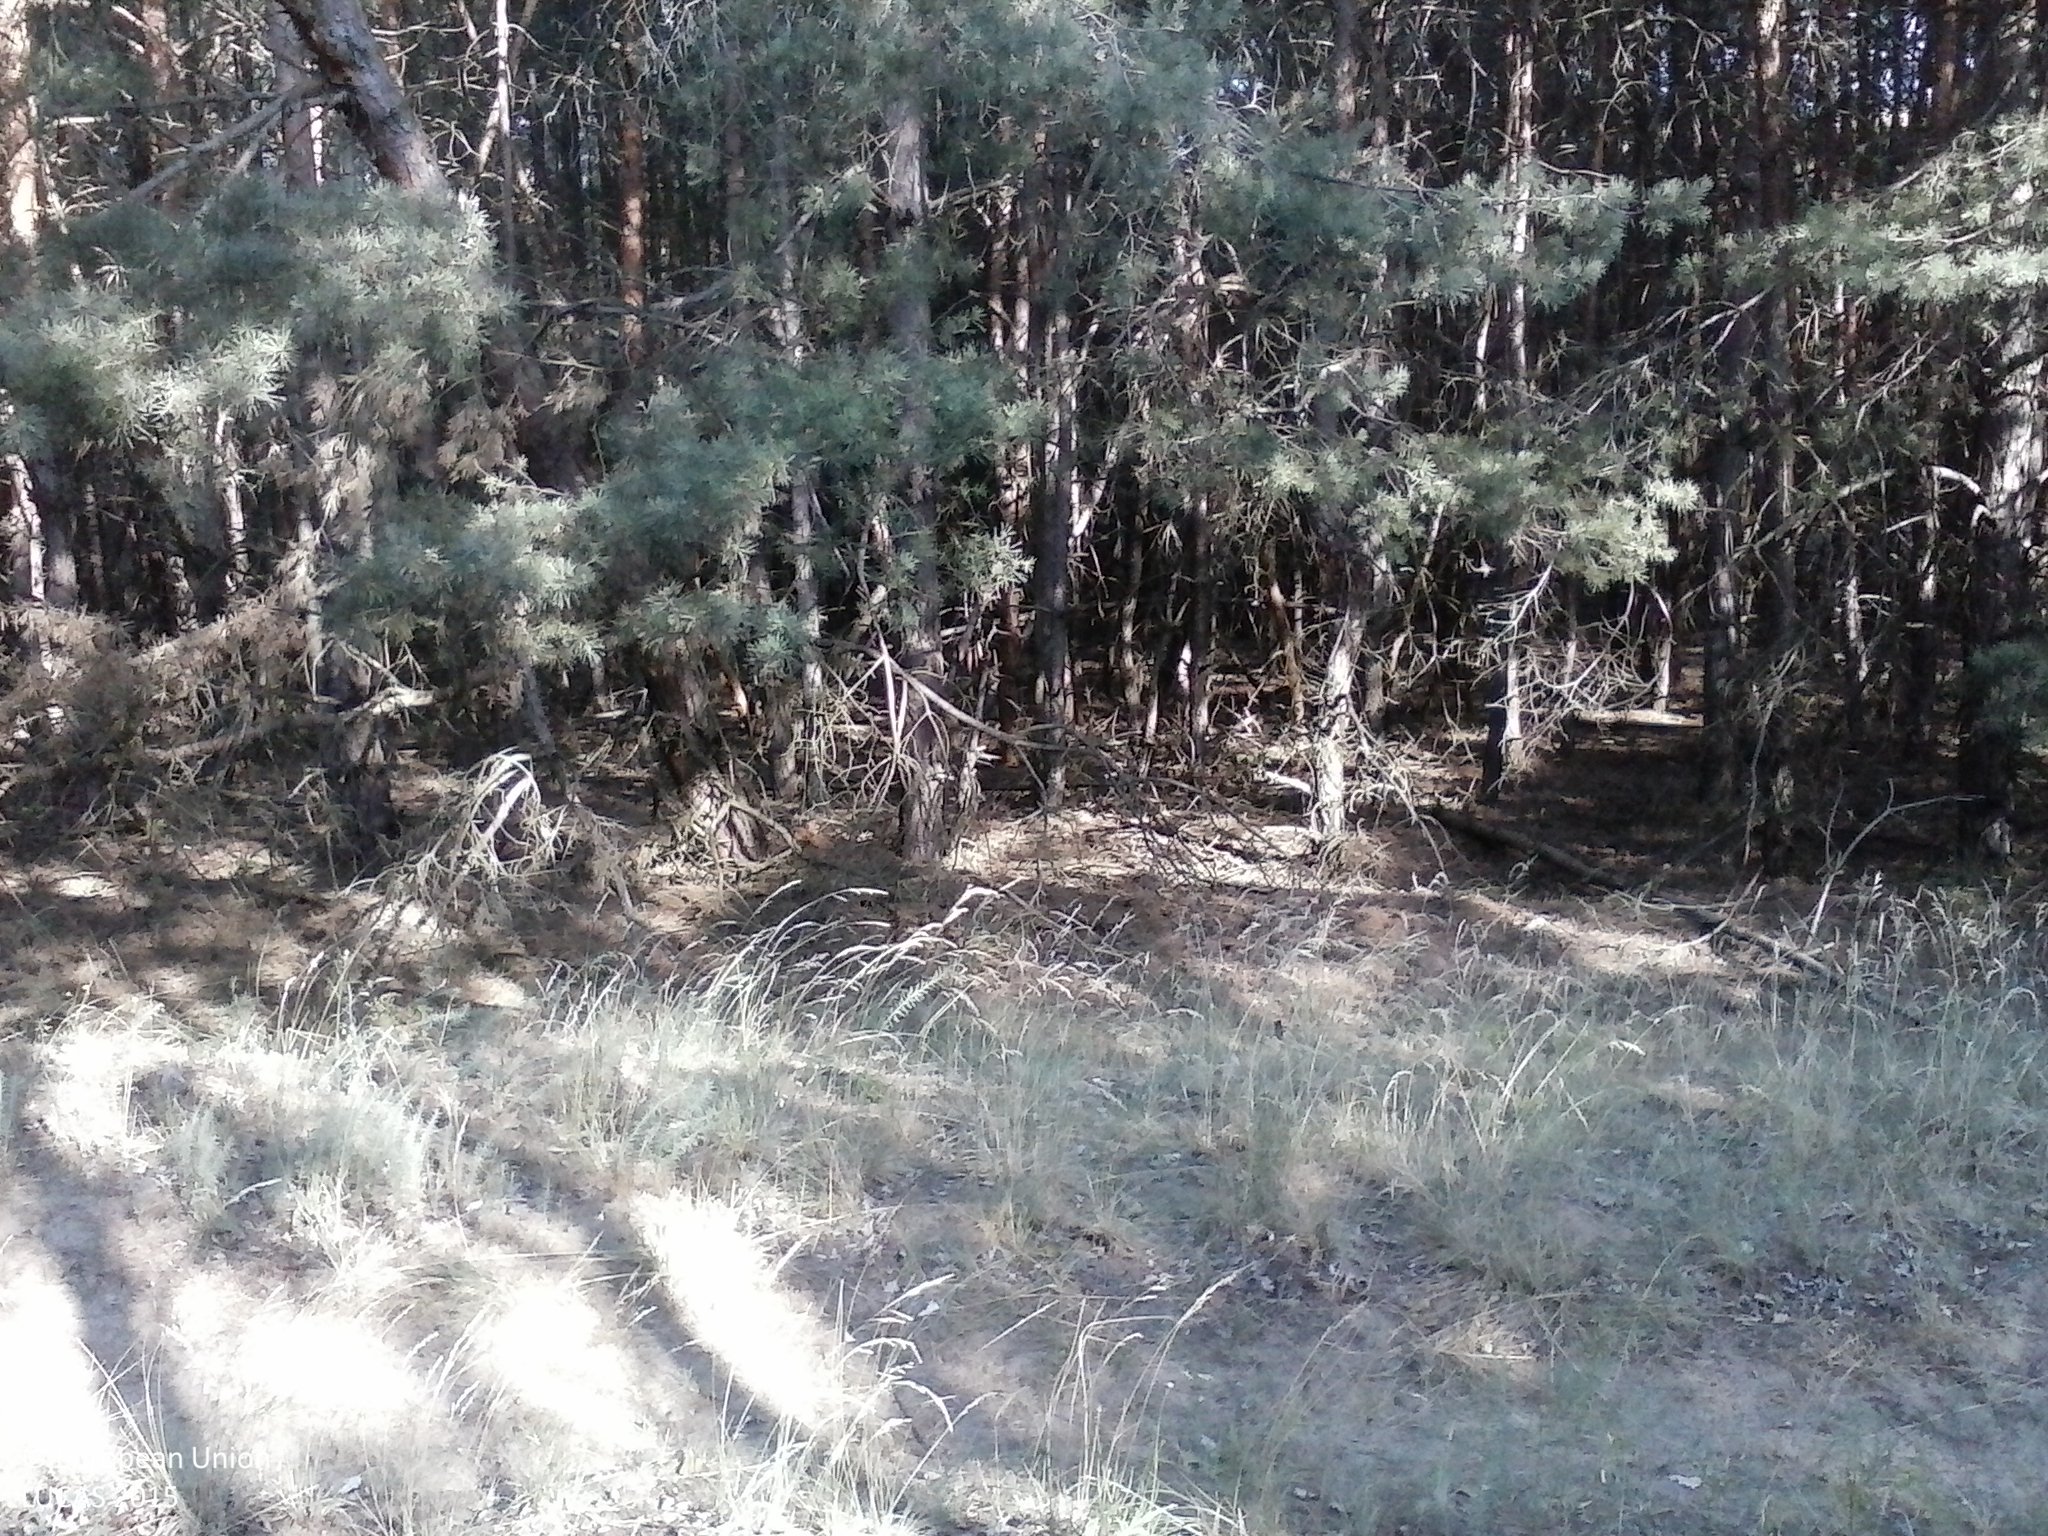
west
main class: Woodland
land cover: Broadleaved woodland
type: mesophytic deciduous forest
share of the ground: > 75 %
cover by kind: broadleaved forest trees 80 %, shrubs 10 %, herbaceous plants 10 %
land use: Forestry
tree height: > 5 m
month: July
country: HU
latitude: 46.4410
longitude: 19.6373
